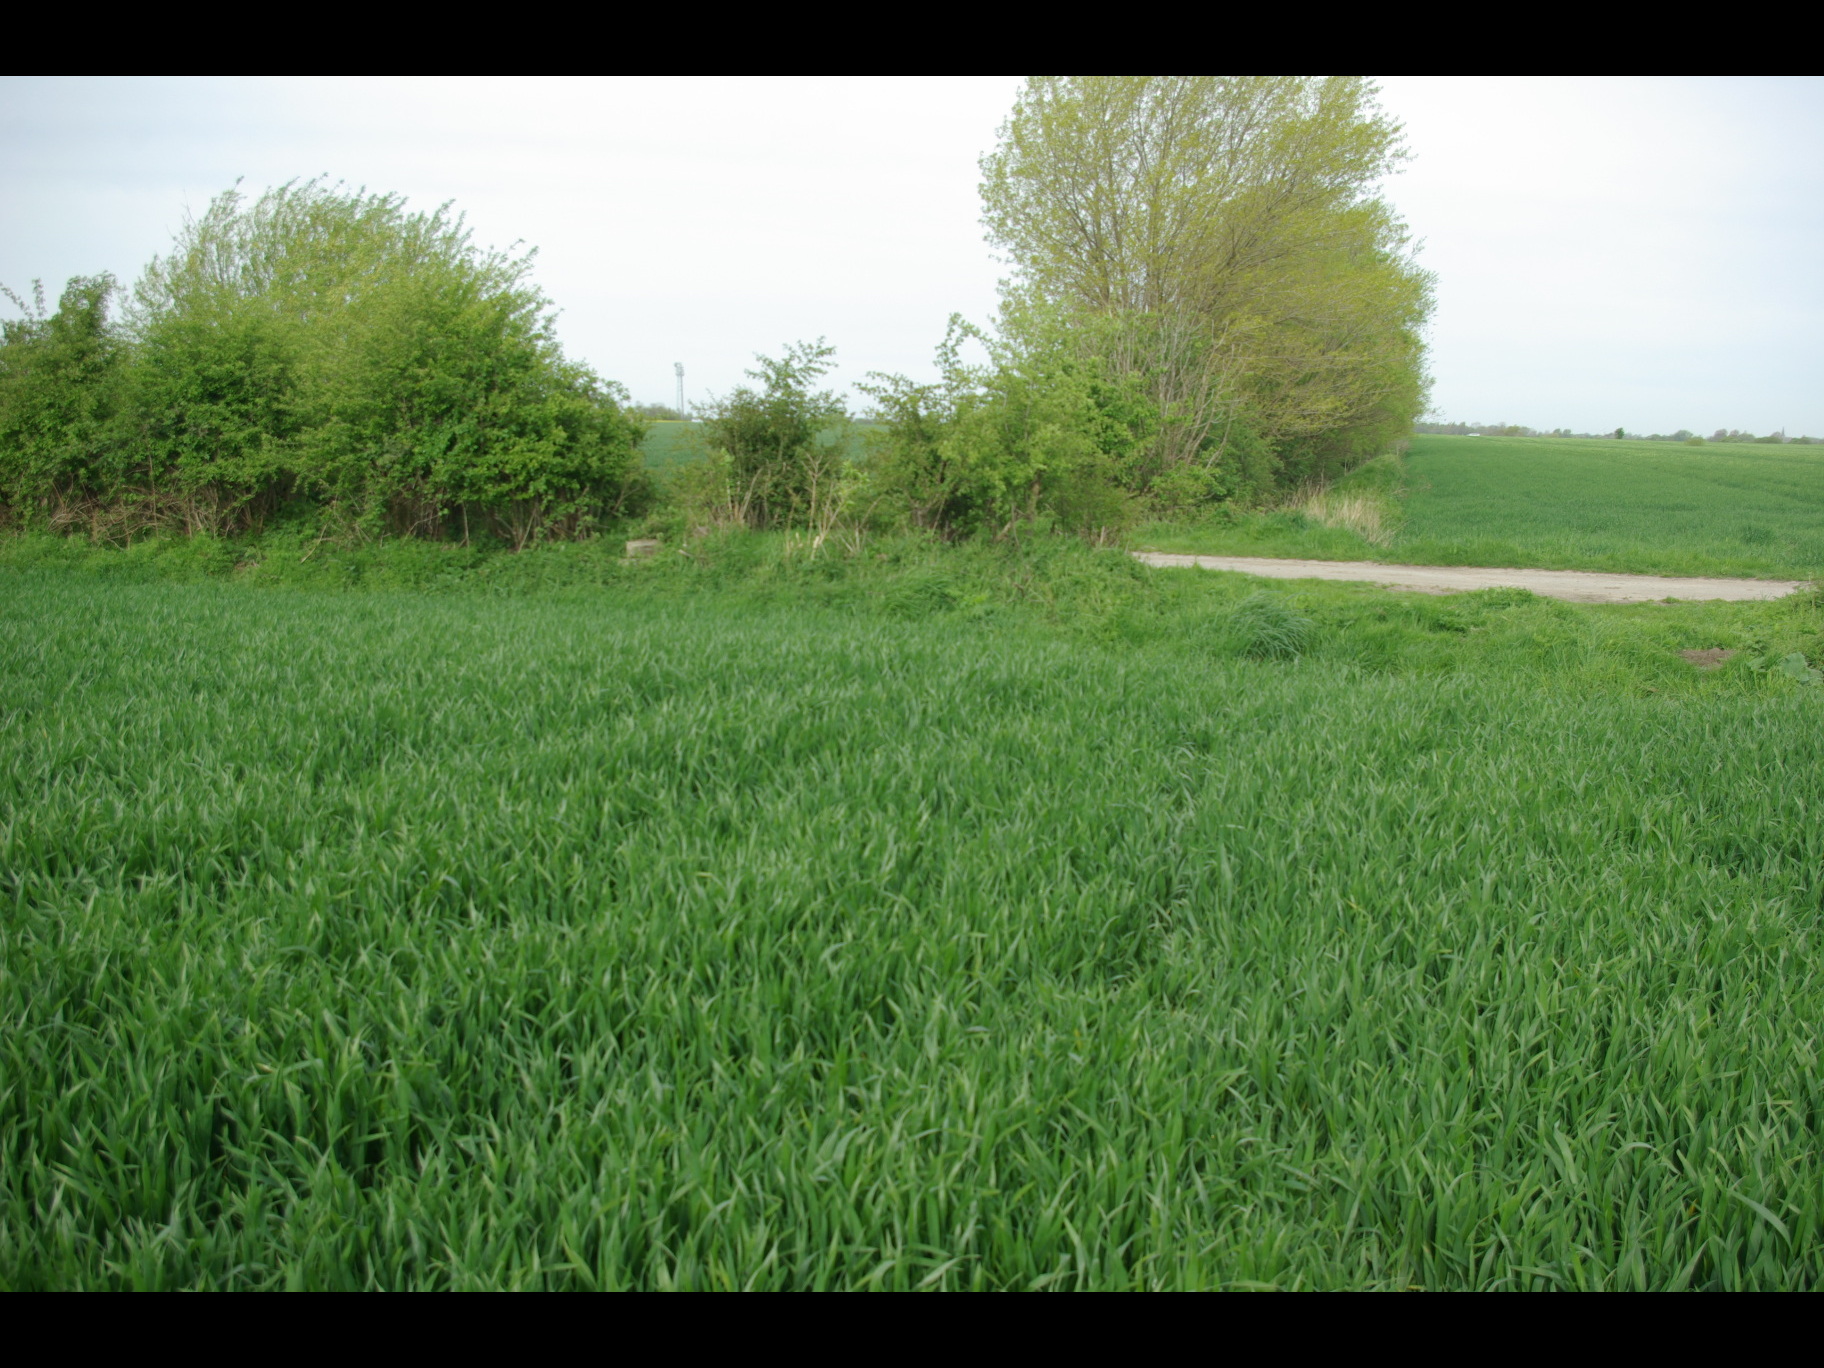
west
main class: Cropland
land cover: Common wheat
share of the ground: > 75 %
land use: Agriculture (excluding fallow land and kitchen gardens)
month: May
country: DE
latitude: 54.4569
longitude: 11.1562
